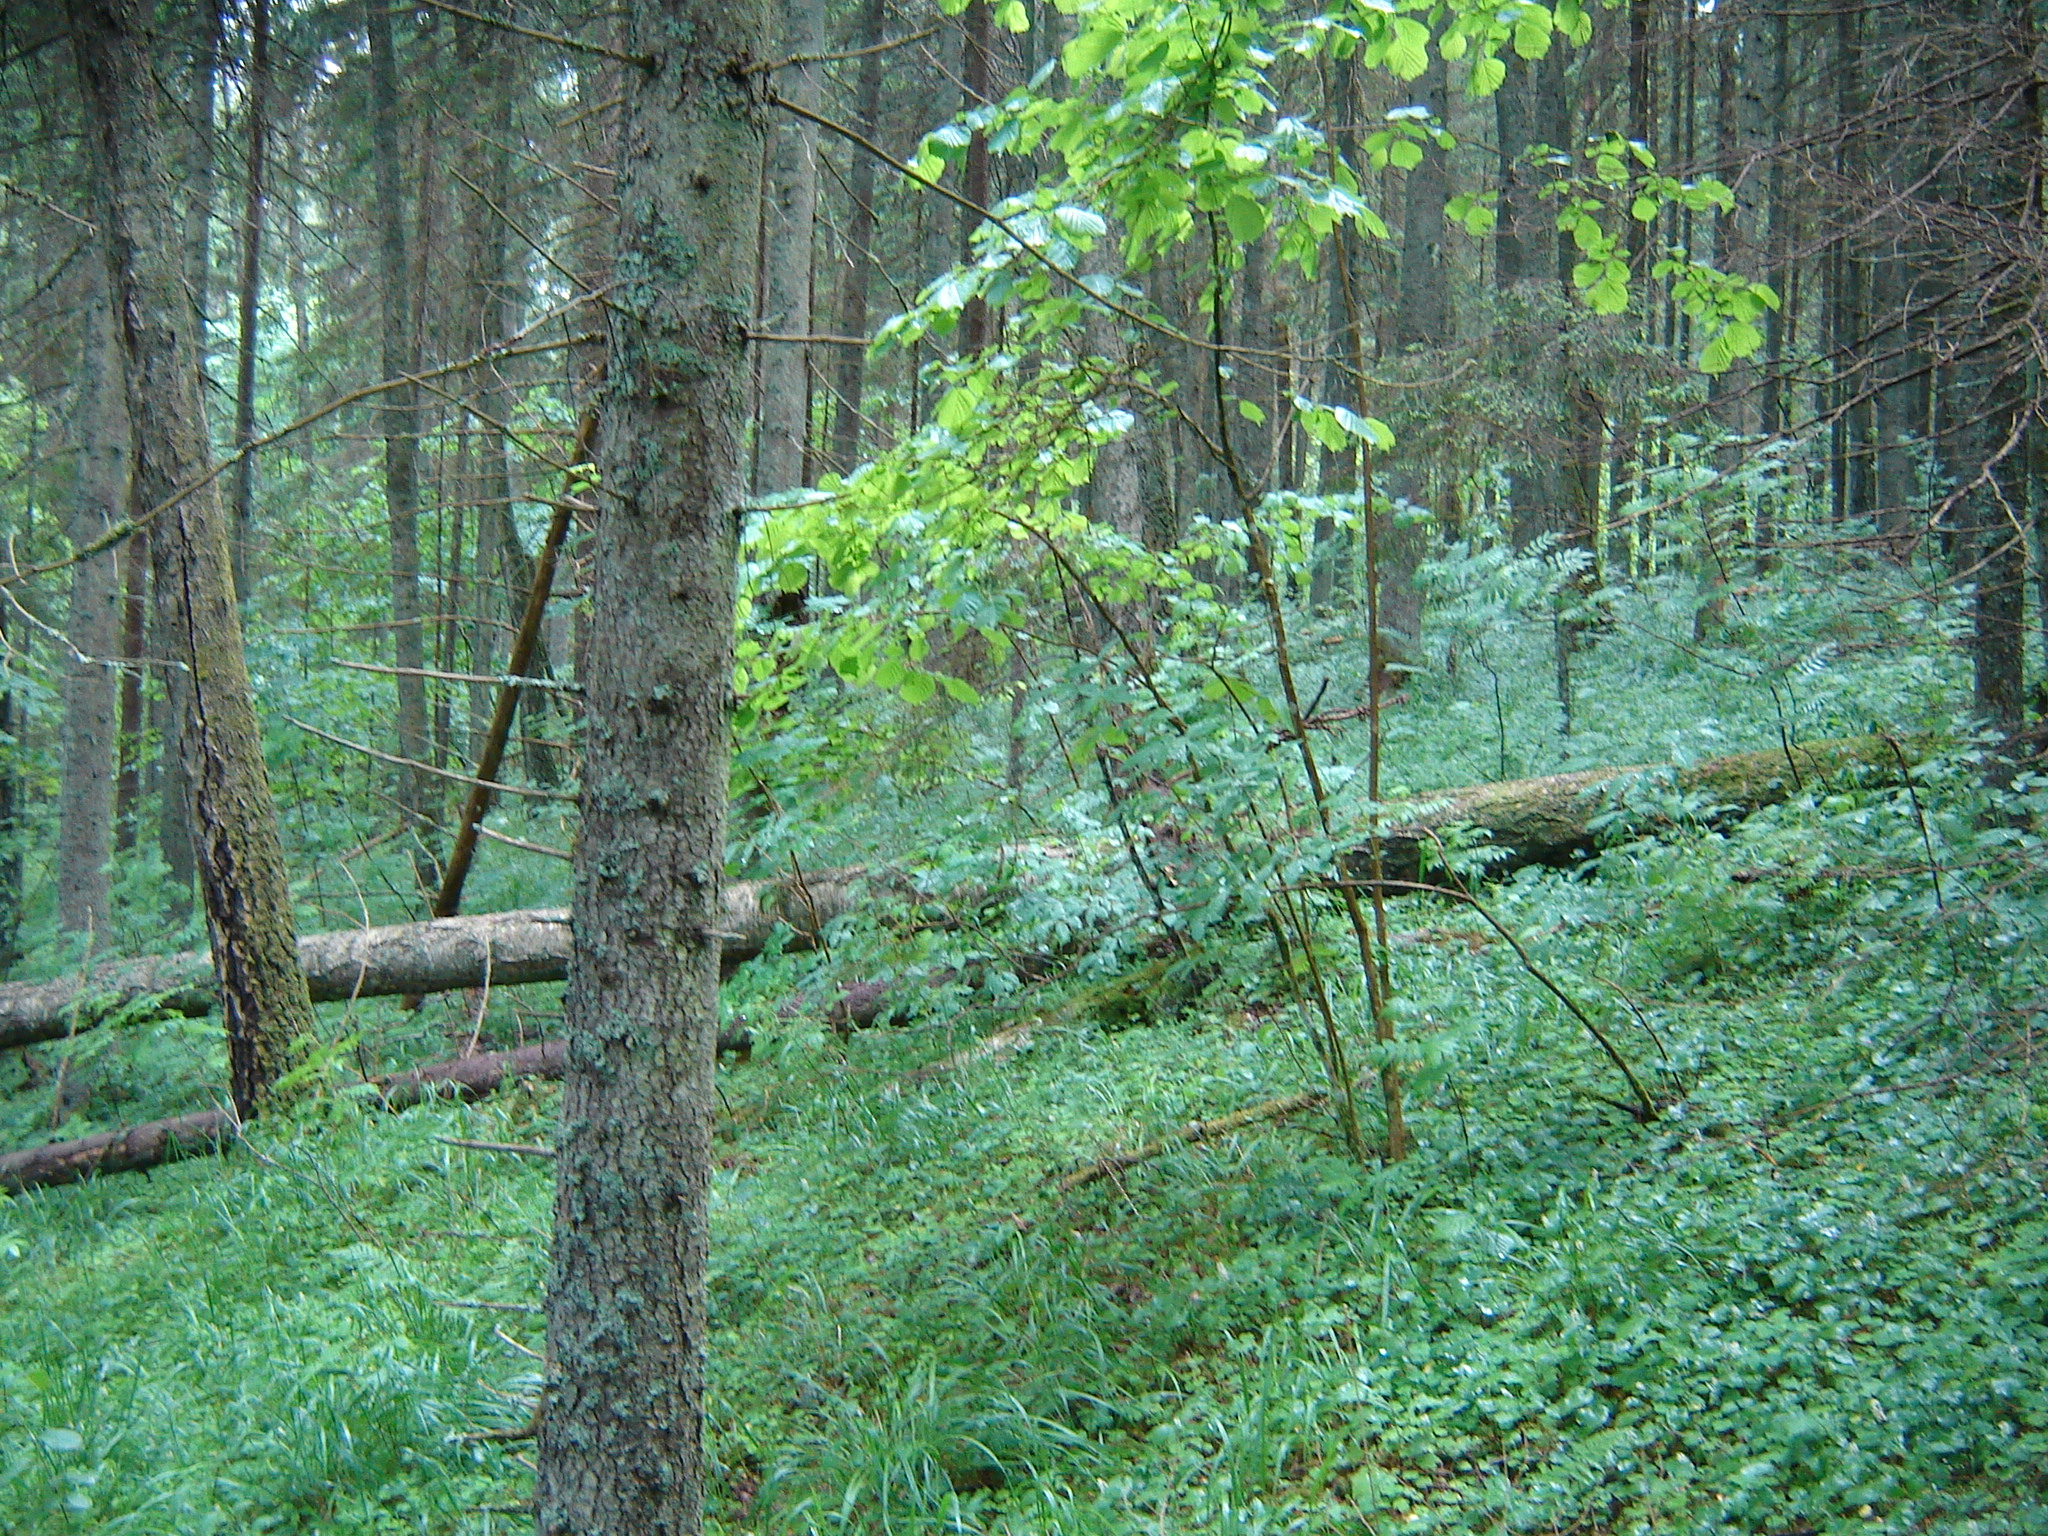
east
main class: Woodland
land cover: Spruce dominated coniferous woodland
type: hemiboreal forest and nemoral coniferous forest and mixed broadleaved-coniferous forest
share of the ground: > 75 %
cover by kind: coniferous forest trees 90 %, broadleaved forest trees 10 %
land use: Forestry
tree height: > 5 m
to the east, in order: Spruce dominated coniferous woodland
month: June
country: LT
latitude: 55.6594
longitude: 25.2006
